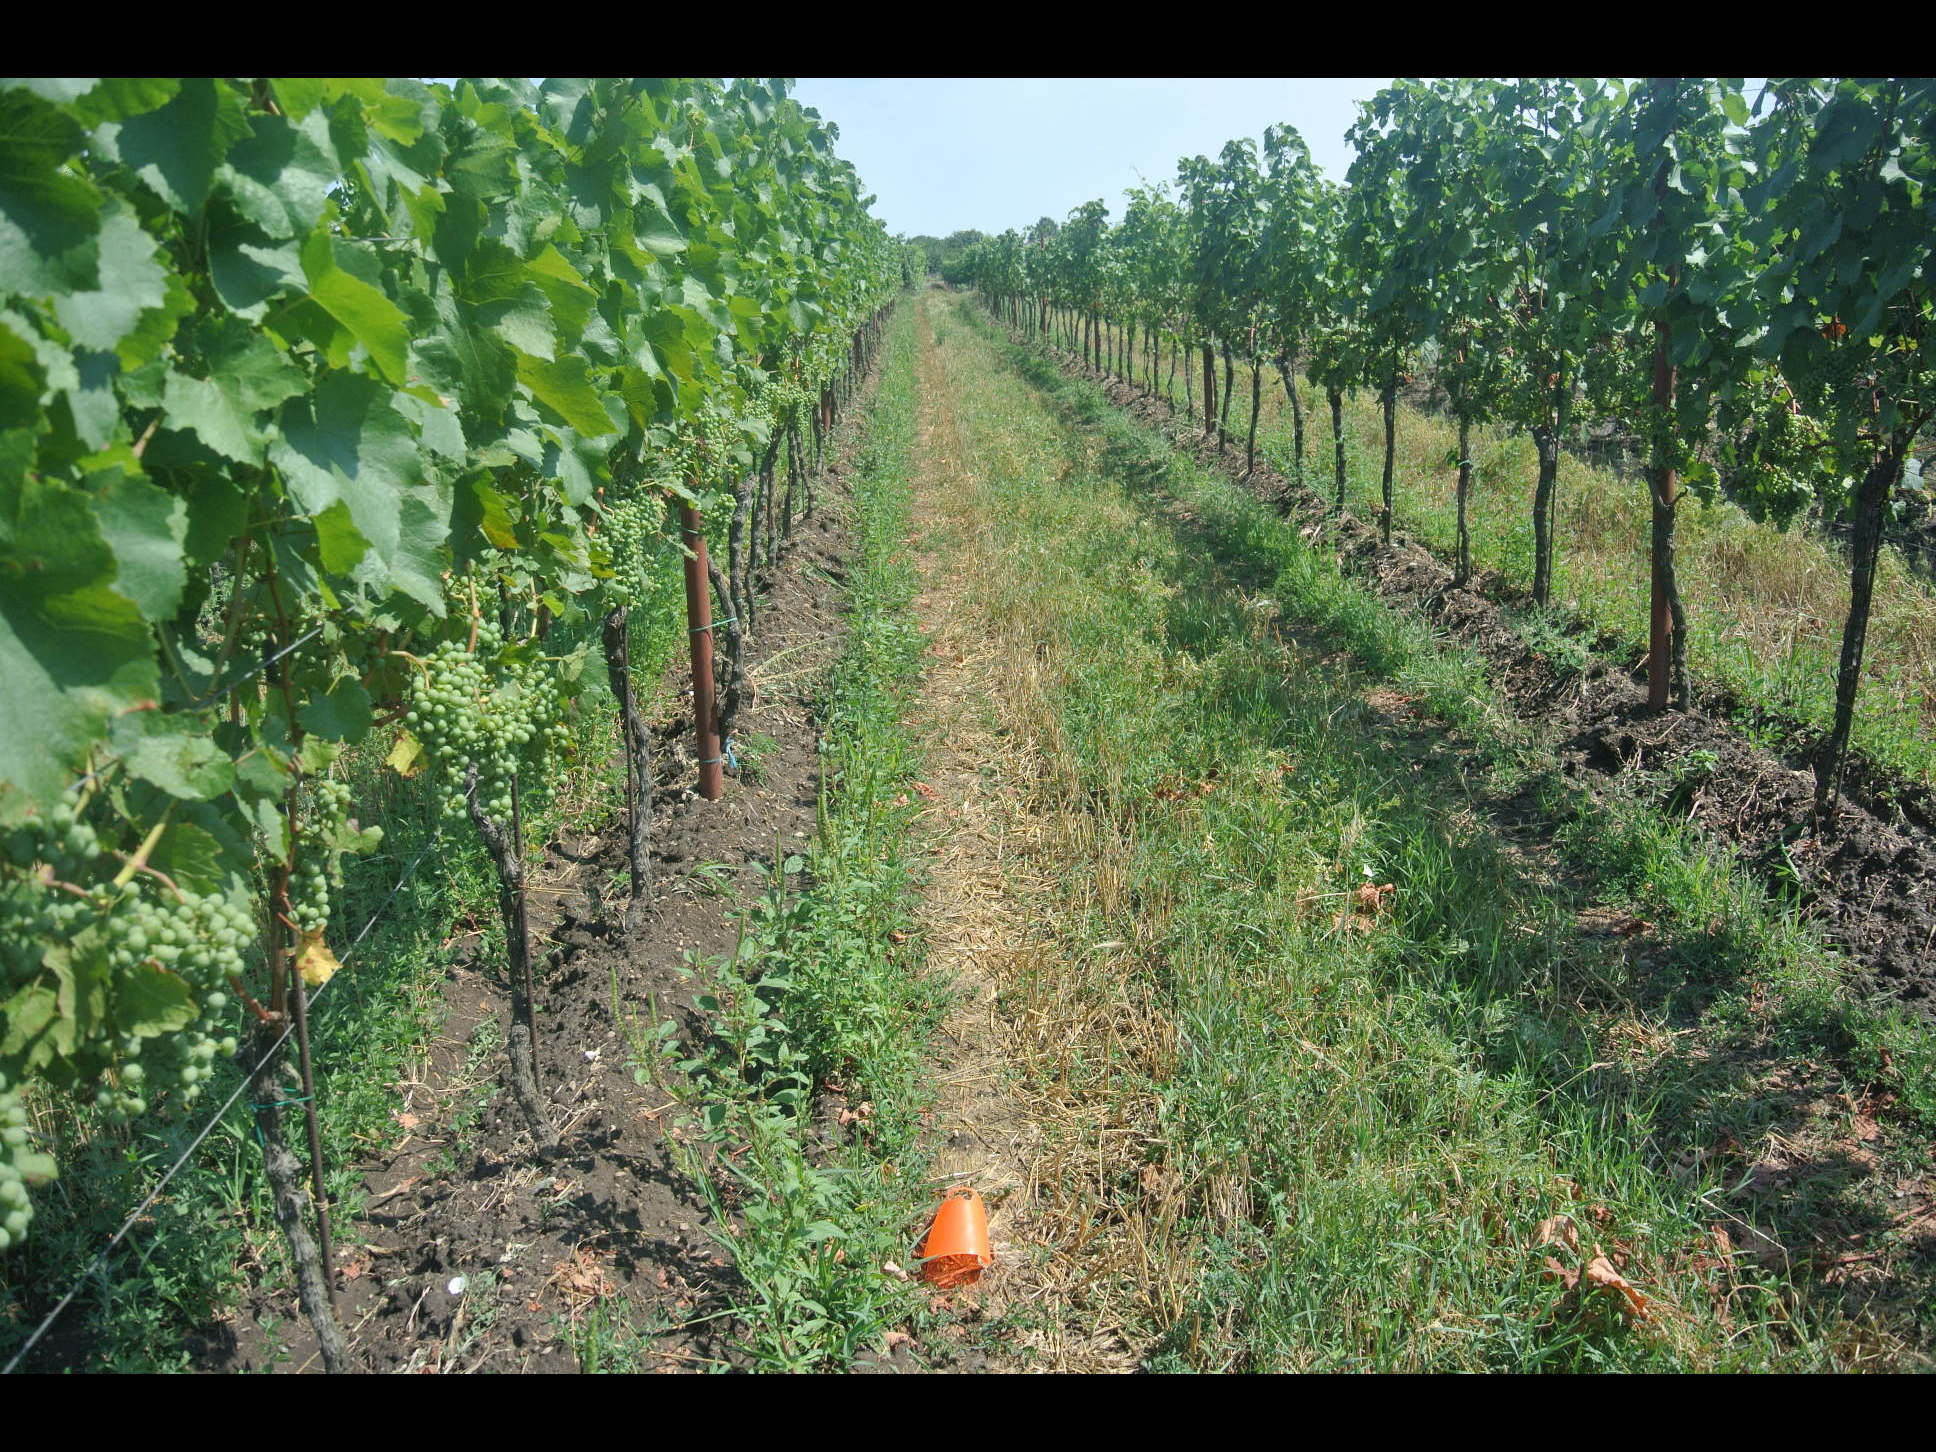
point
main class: Cropland
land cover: Vineyards
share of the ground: 25 - 50 %
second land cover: Grassland without tree/shrub cover
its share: > 75 %
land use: Agriculture (excluding fallow land and kitchen gardens)
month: July
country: AT
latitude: 47.7005
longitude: 16.8953
